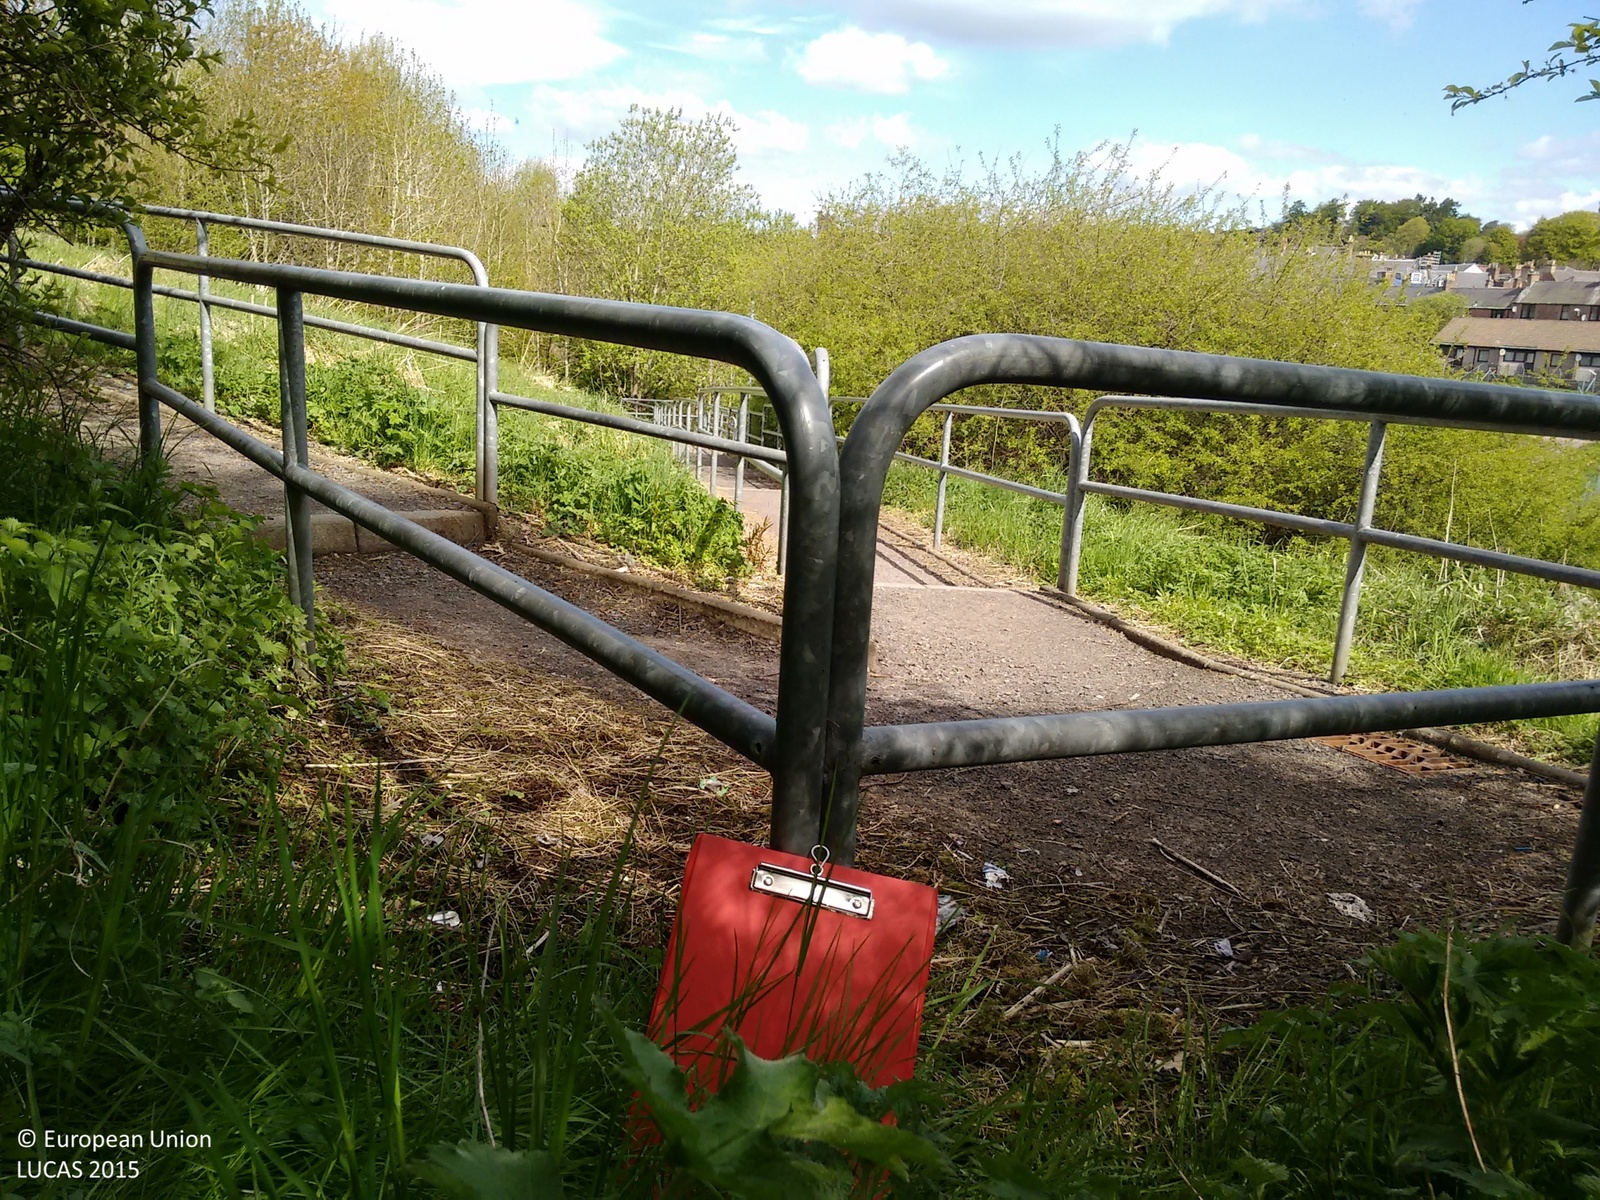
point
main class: Woodland
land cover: Broadleaved woodland
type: mesophytic deciduous forest
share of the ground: > 75 %
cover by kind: broadleaved forest trees 75 %, herbaceous plants 25 %
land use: Amenities, museums, leisure
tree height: > 5 m
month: May
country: GB
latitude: 56.6714
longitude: -3.0062
